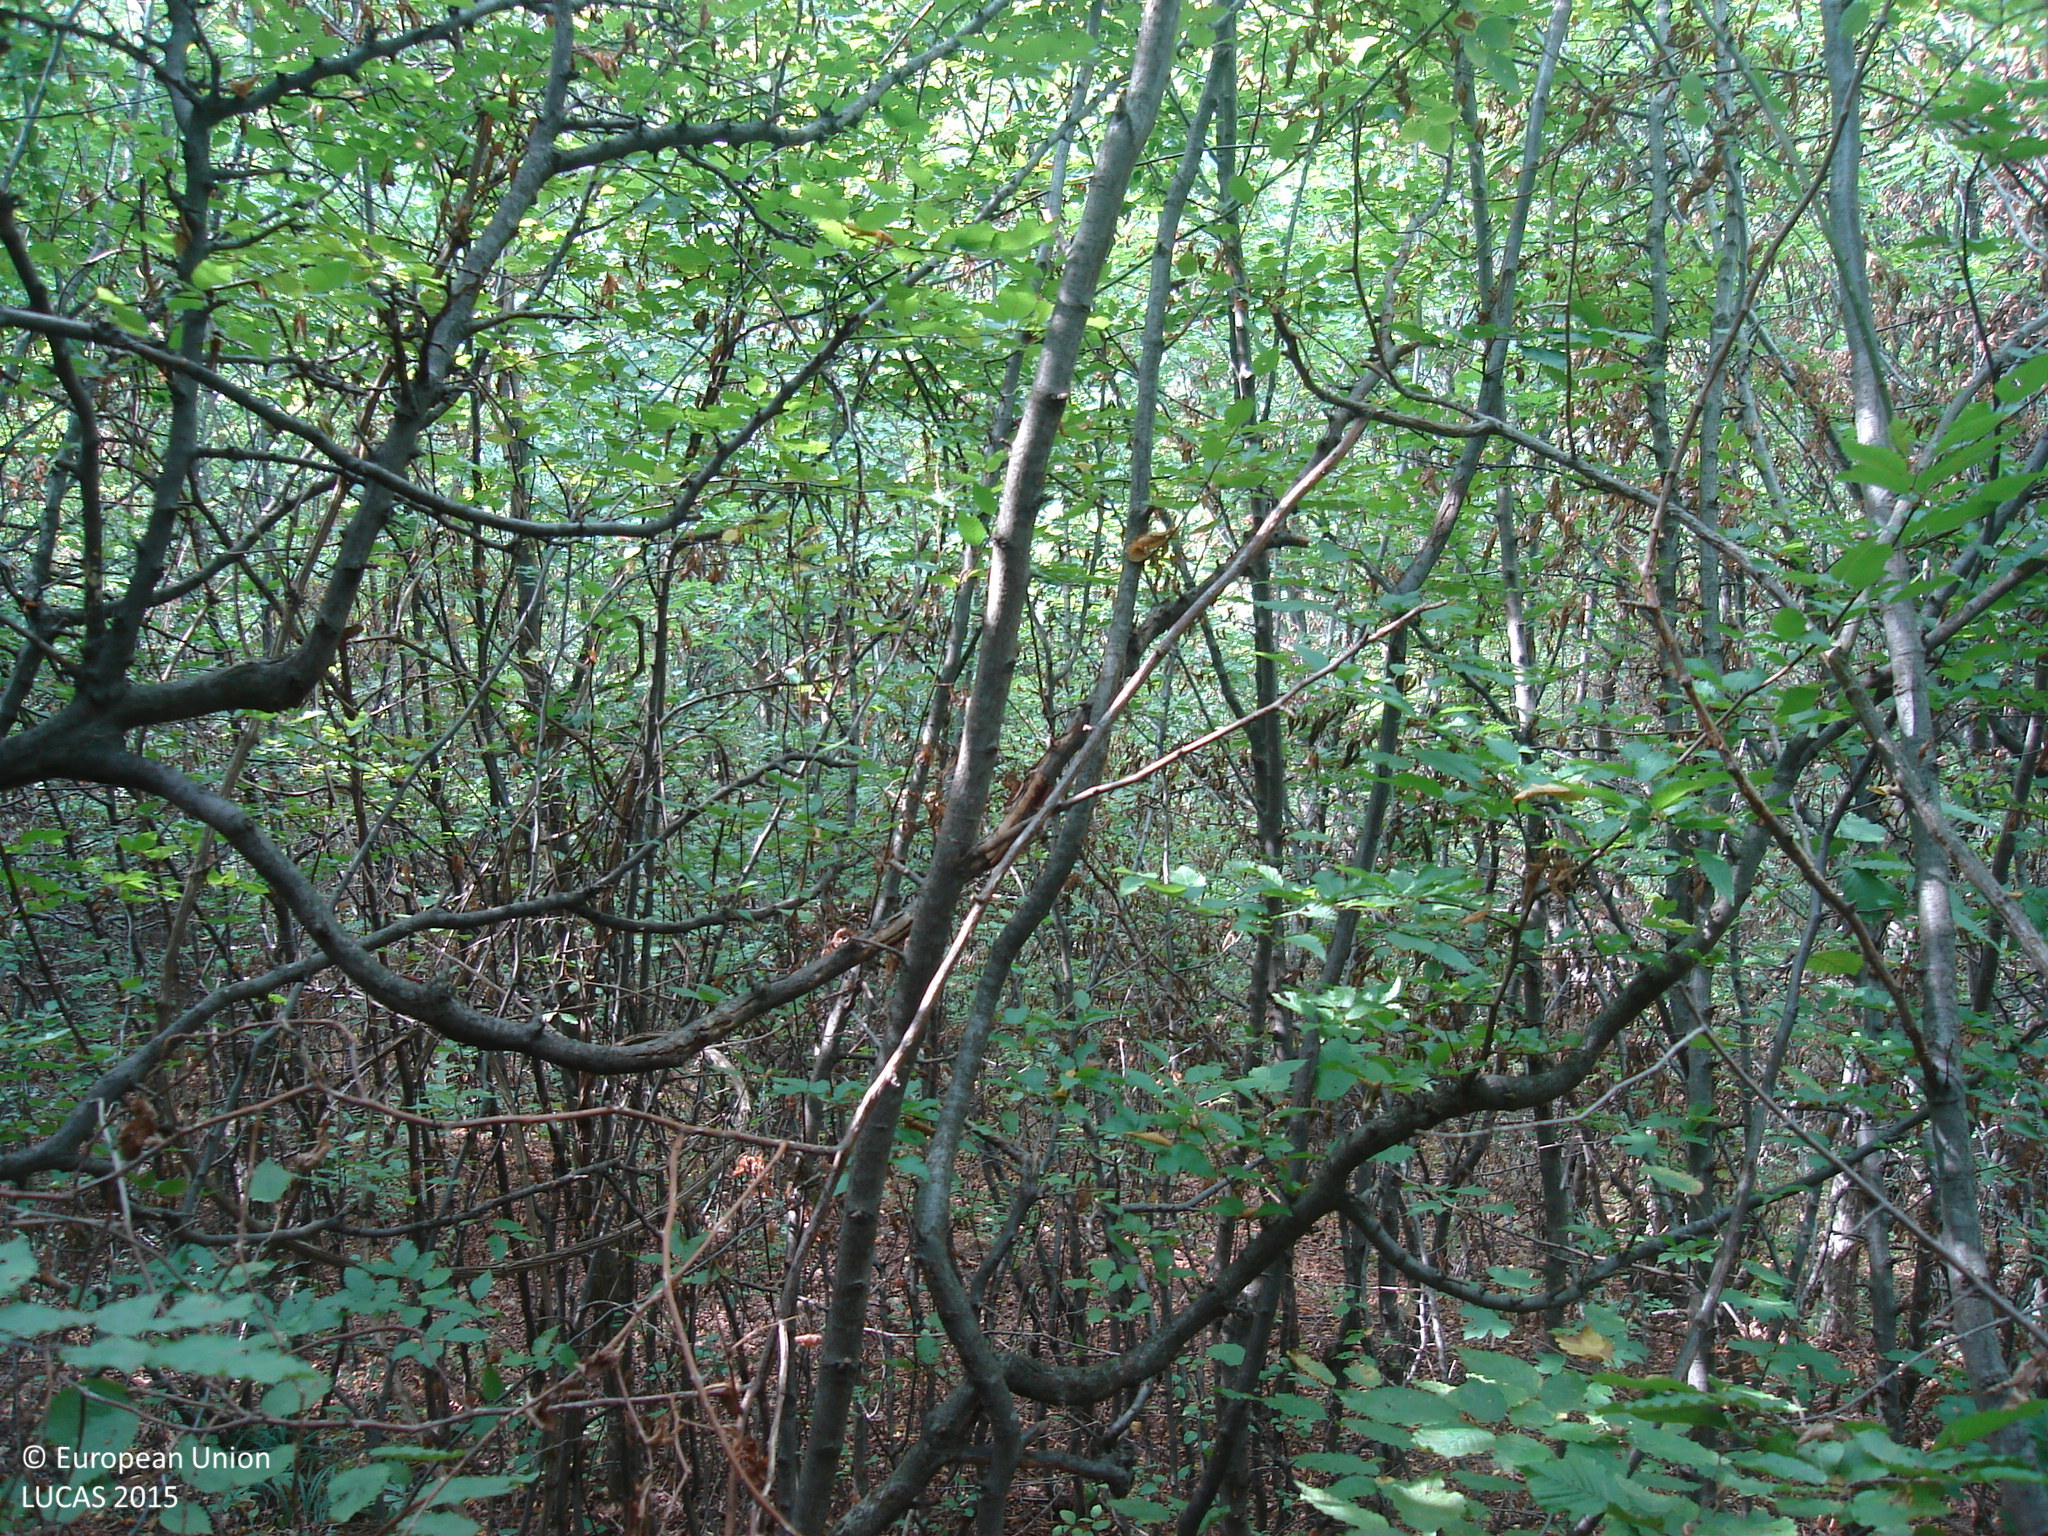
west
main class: Woodland
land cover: Broadleaved woodland
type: mesophytic deciduous forest
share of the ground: > 75 %
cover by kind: broadleaved forest trees 95 %, consolidated bare surface 5 %
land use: Forestry
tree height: < 5 m
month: September
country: BG
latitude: 43.1151
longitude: 23.3734
